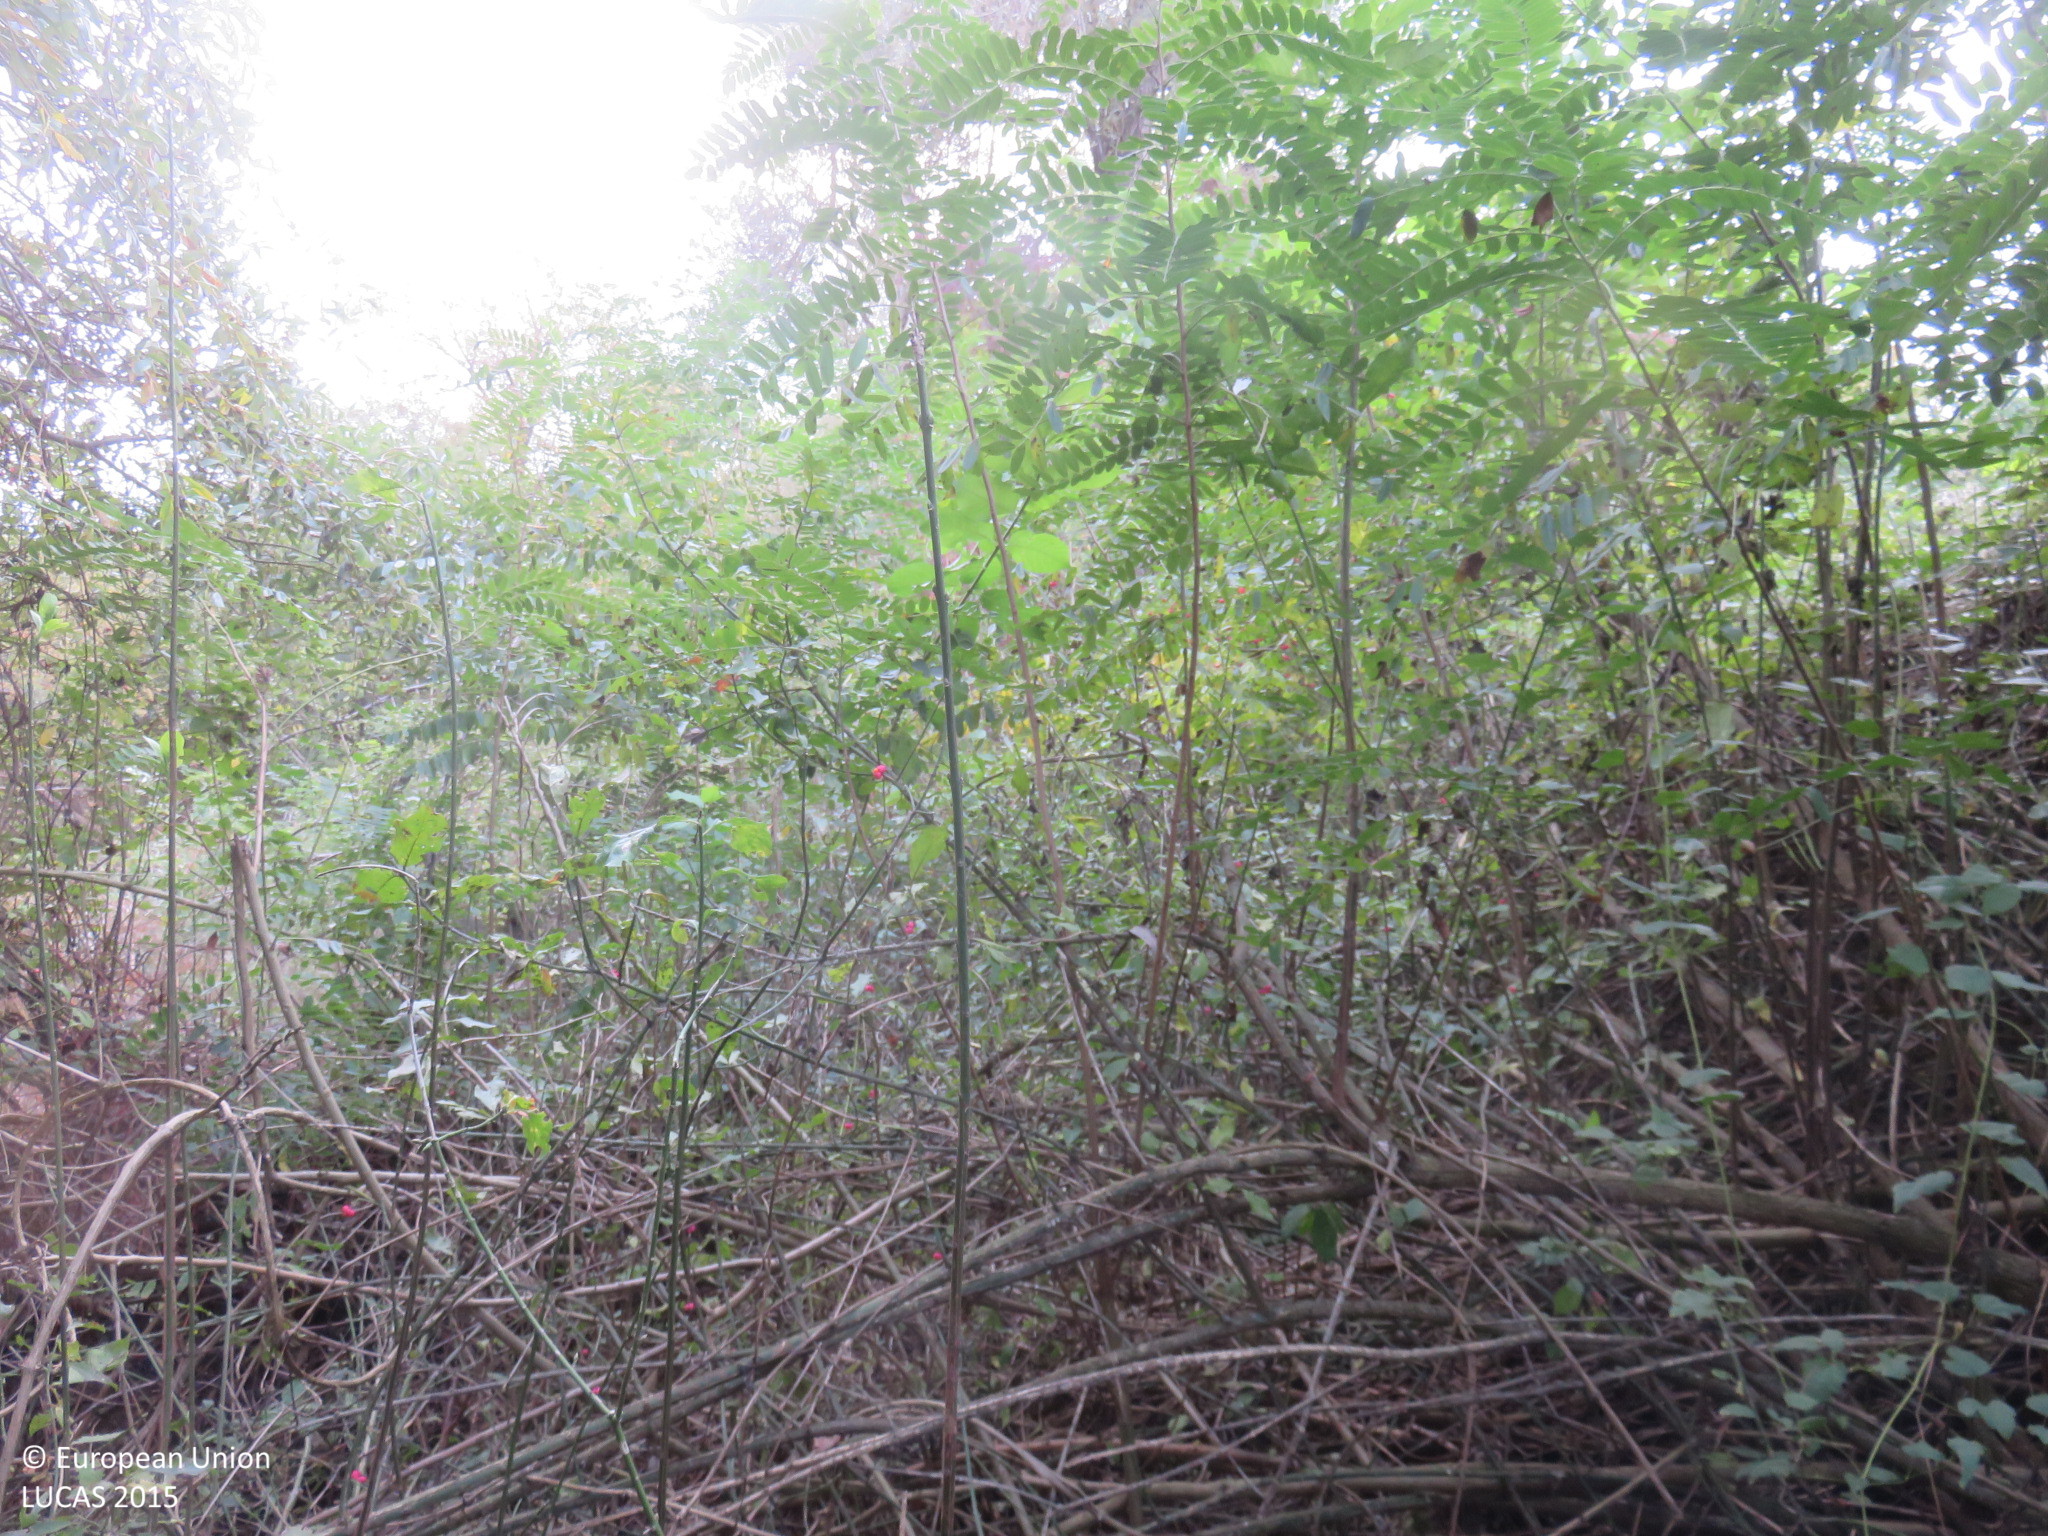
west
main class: Woodland
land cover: Broadleaved woodland
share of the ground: 50 - 75 %
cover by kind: broadleaved forest trees 60 %, shrubs 40 %
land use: Semi-natural and natural areas not in use
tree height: < 5 m
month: October
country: BG
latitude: 42.9580
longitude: 25.1336
